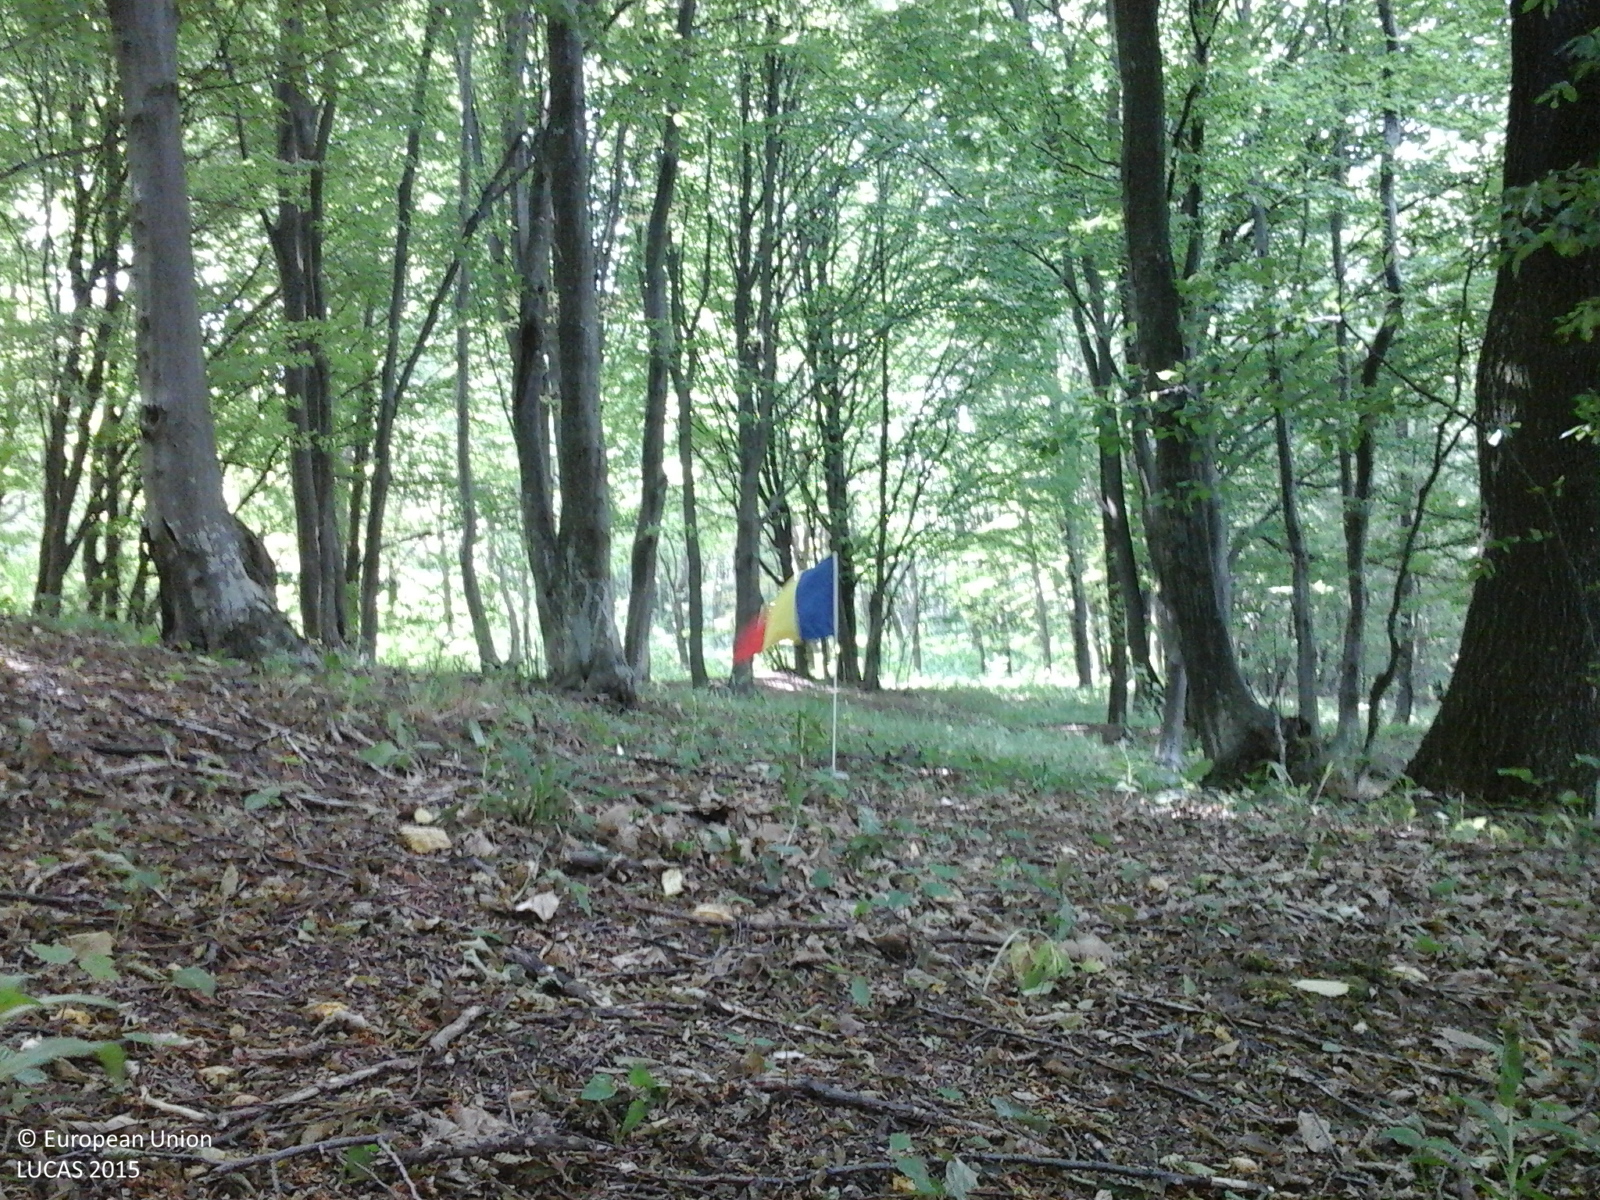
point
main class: Woodland
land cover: Broadleaved woodland
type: beech forest
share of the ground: > 75 %
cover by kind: broadleaved forest trees 100 %
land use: Forestry
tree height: > 5 m
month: June
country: RO
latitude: 47.4030
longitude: 26.7789
